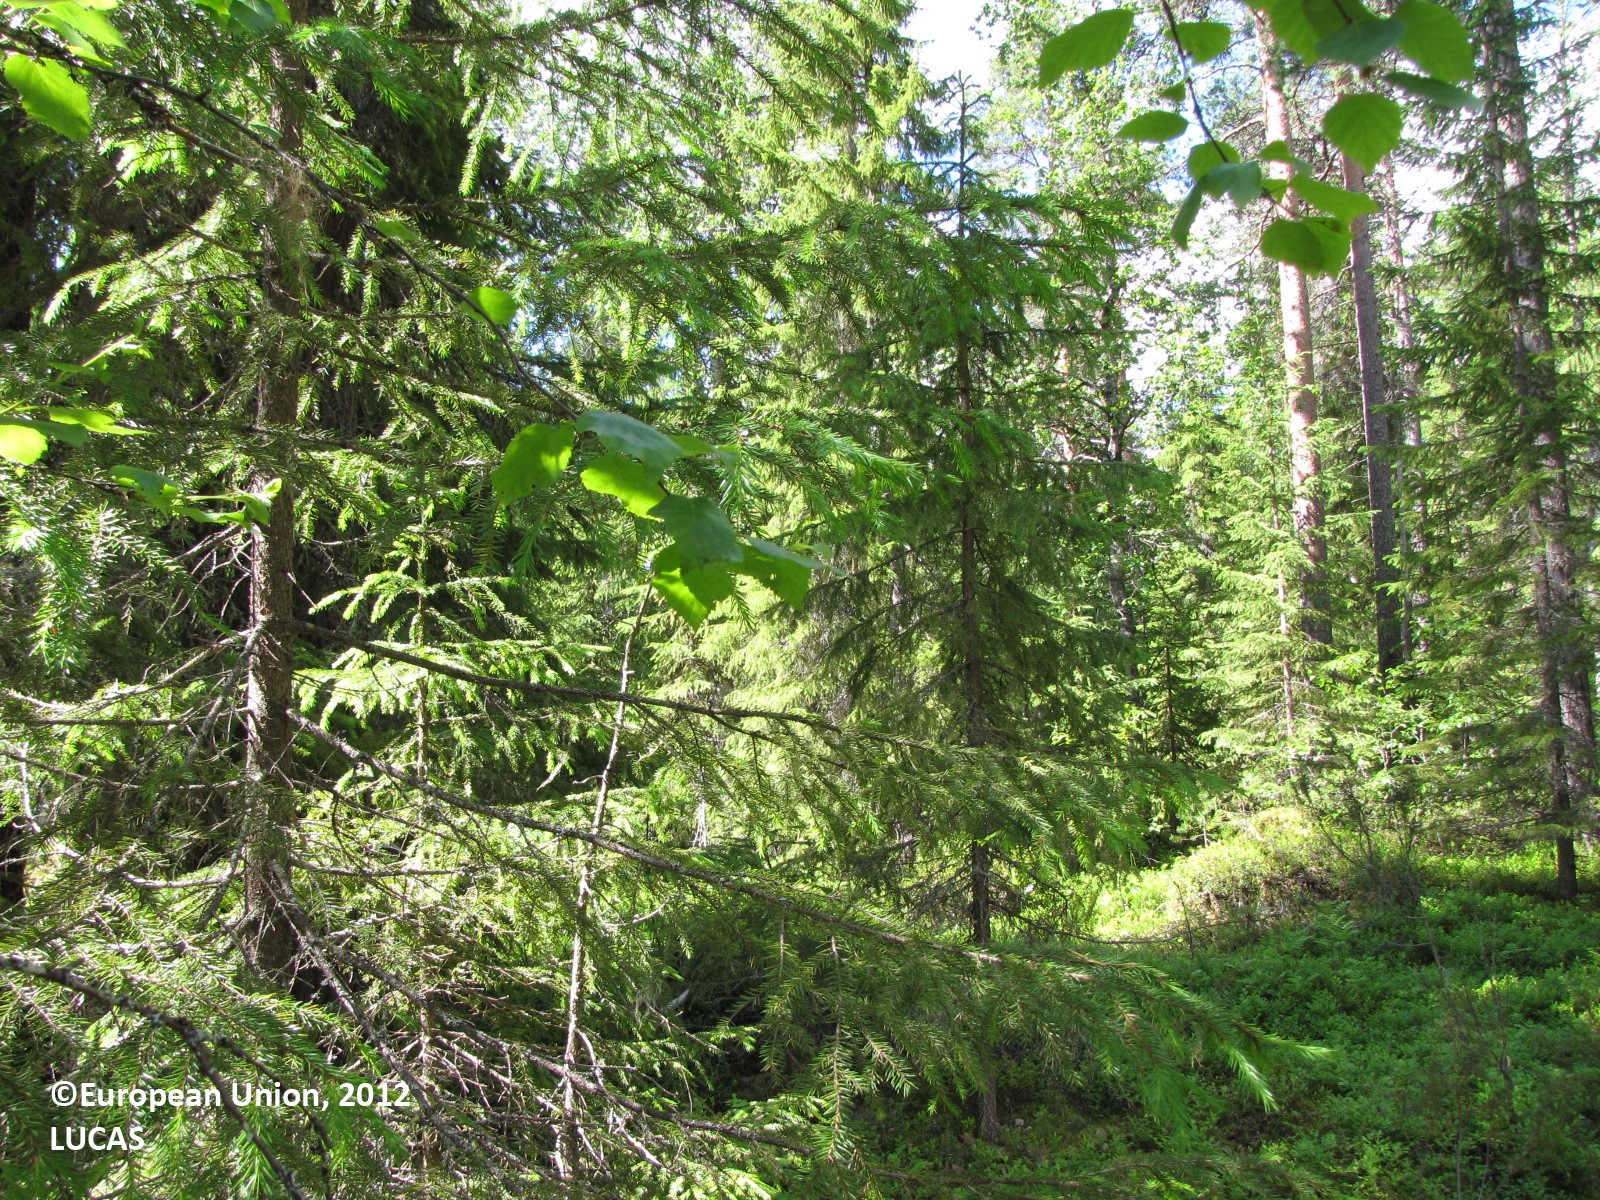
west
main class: Woodland
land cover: Spruce dominated coniferous woodland
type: boreal forest
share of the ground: 50 - 75 %
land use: Forestry
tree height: > 5 m
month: July
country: FI
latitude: 66.1811
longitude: 25.1281
